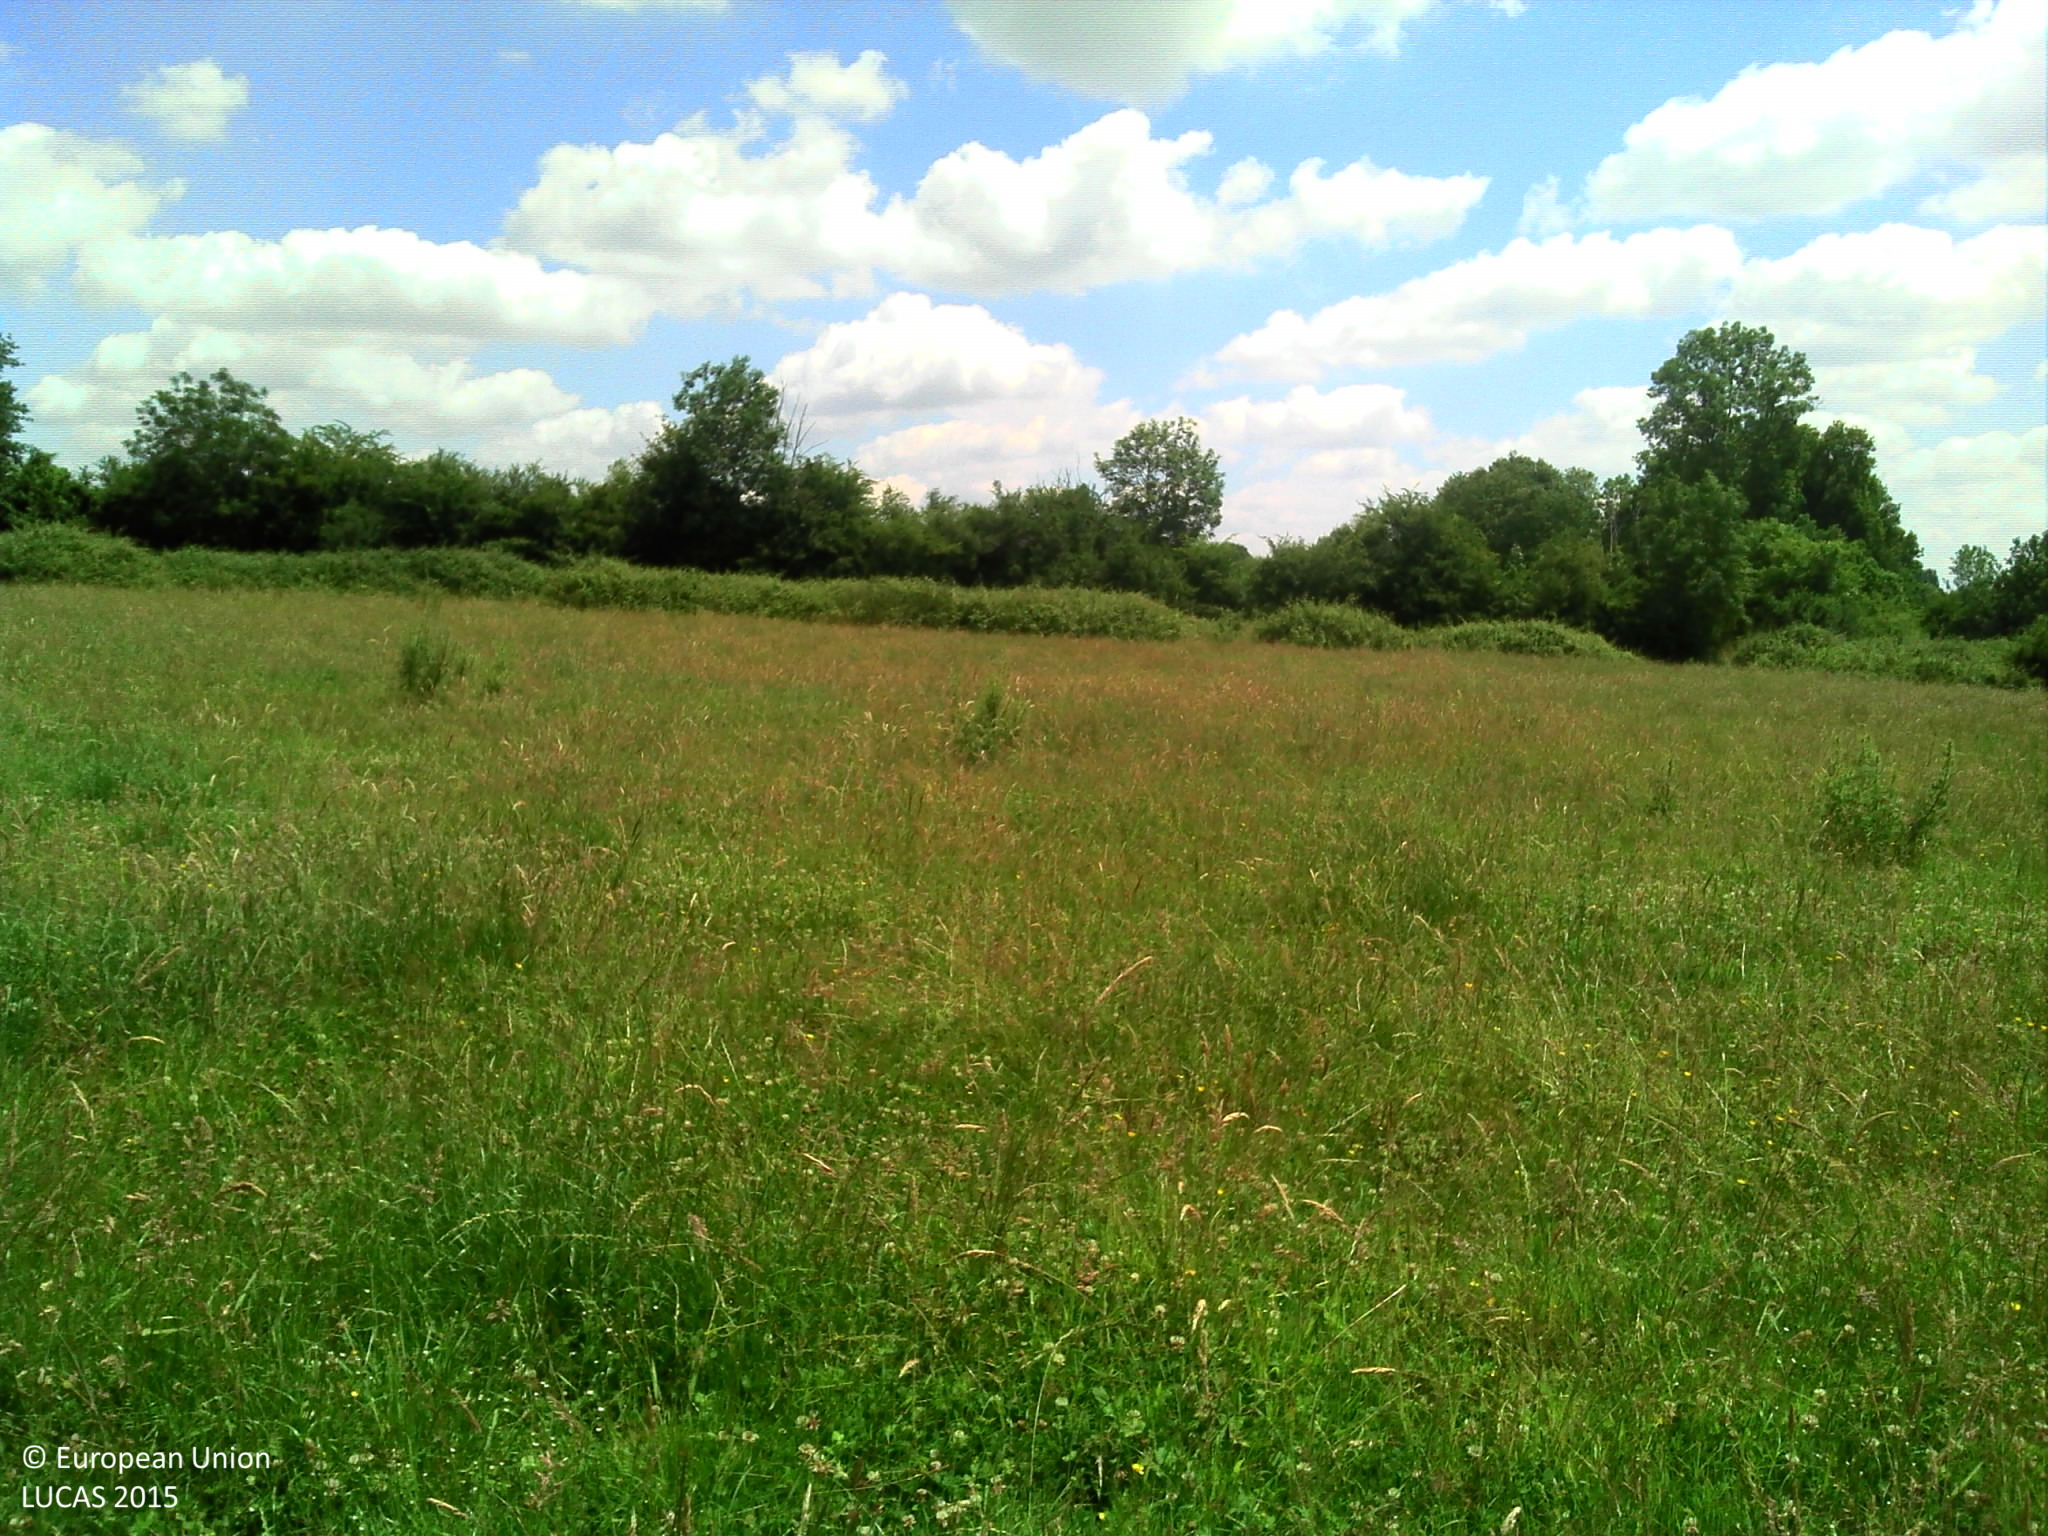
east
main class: Grassland
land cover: Grassland without tree/shrub cover
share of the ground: > 75 %
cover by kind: herbaceous plants 100 %
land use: Agriculture (excluding fallow land and kitchen gardens)
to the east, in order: Grassland without tree/shrub cover; Fences; Broadleaved woodland; Ditches and canals; Fences; Triticale; Abandoned hedges; Spontaneously vegetated surfaces
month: June
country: FR
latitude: 47.4008
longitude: 2.6656
